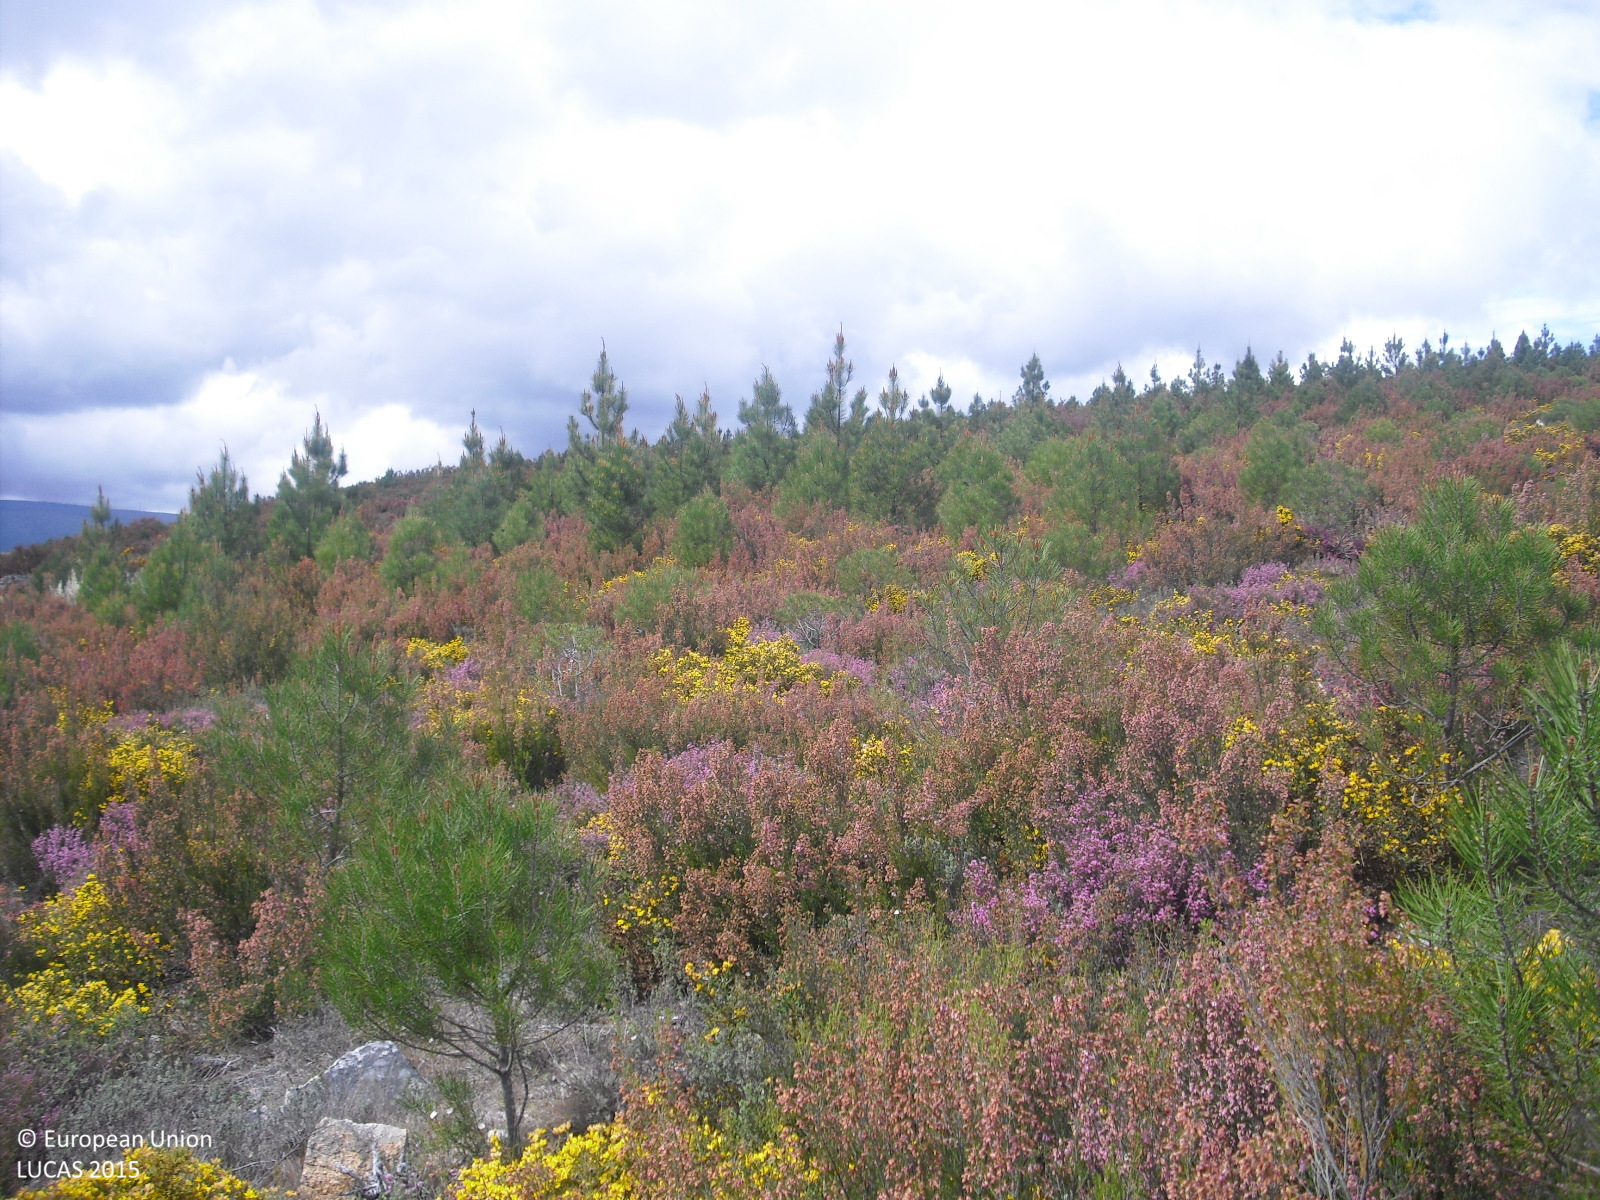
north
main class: Woodland
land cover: Pine dominated coniferous woodland
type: exotic forest
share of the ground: 10 - 25 %
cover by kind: shrubs 50 %, coniferous forest trees 30 %, herbaceous plants 15 %, consolidated bare surface 5 %
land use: Forestry
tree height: < 5 m
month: April
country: ES
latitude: 41.8348
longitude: -7.6078
